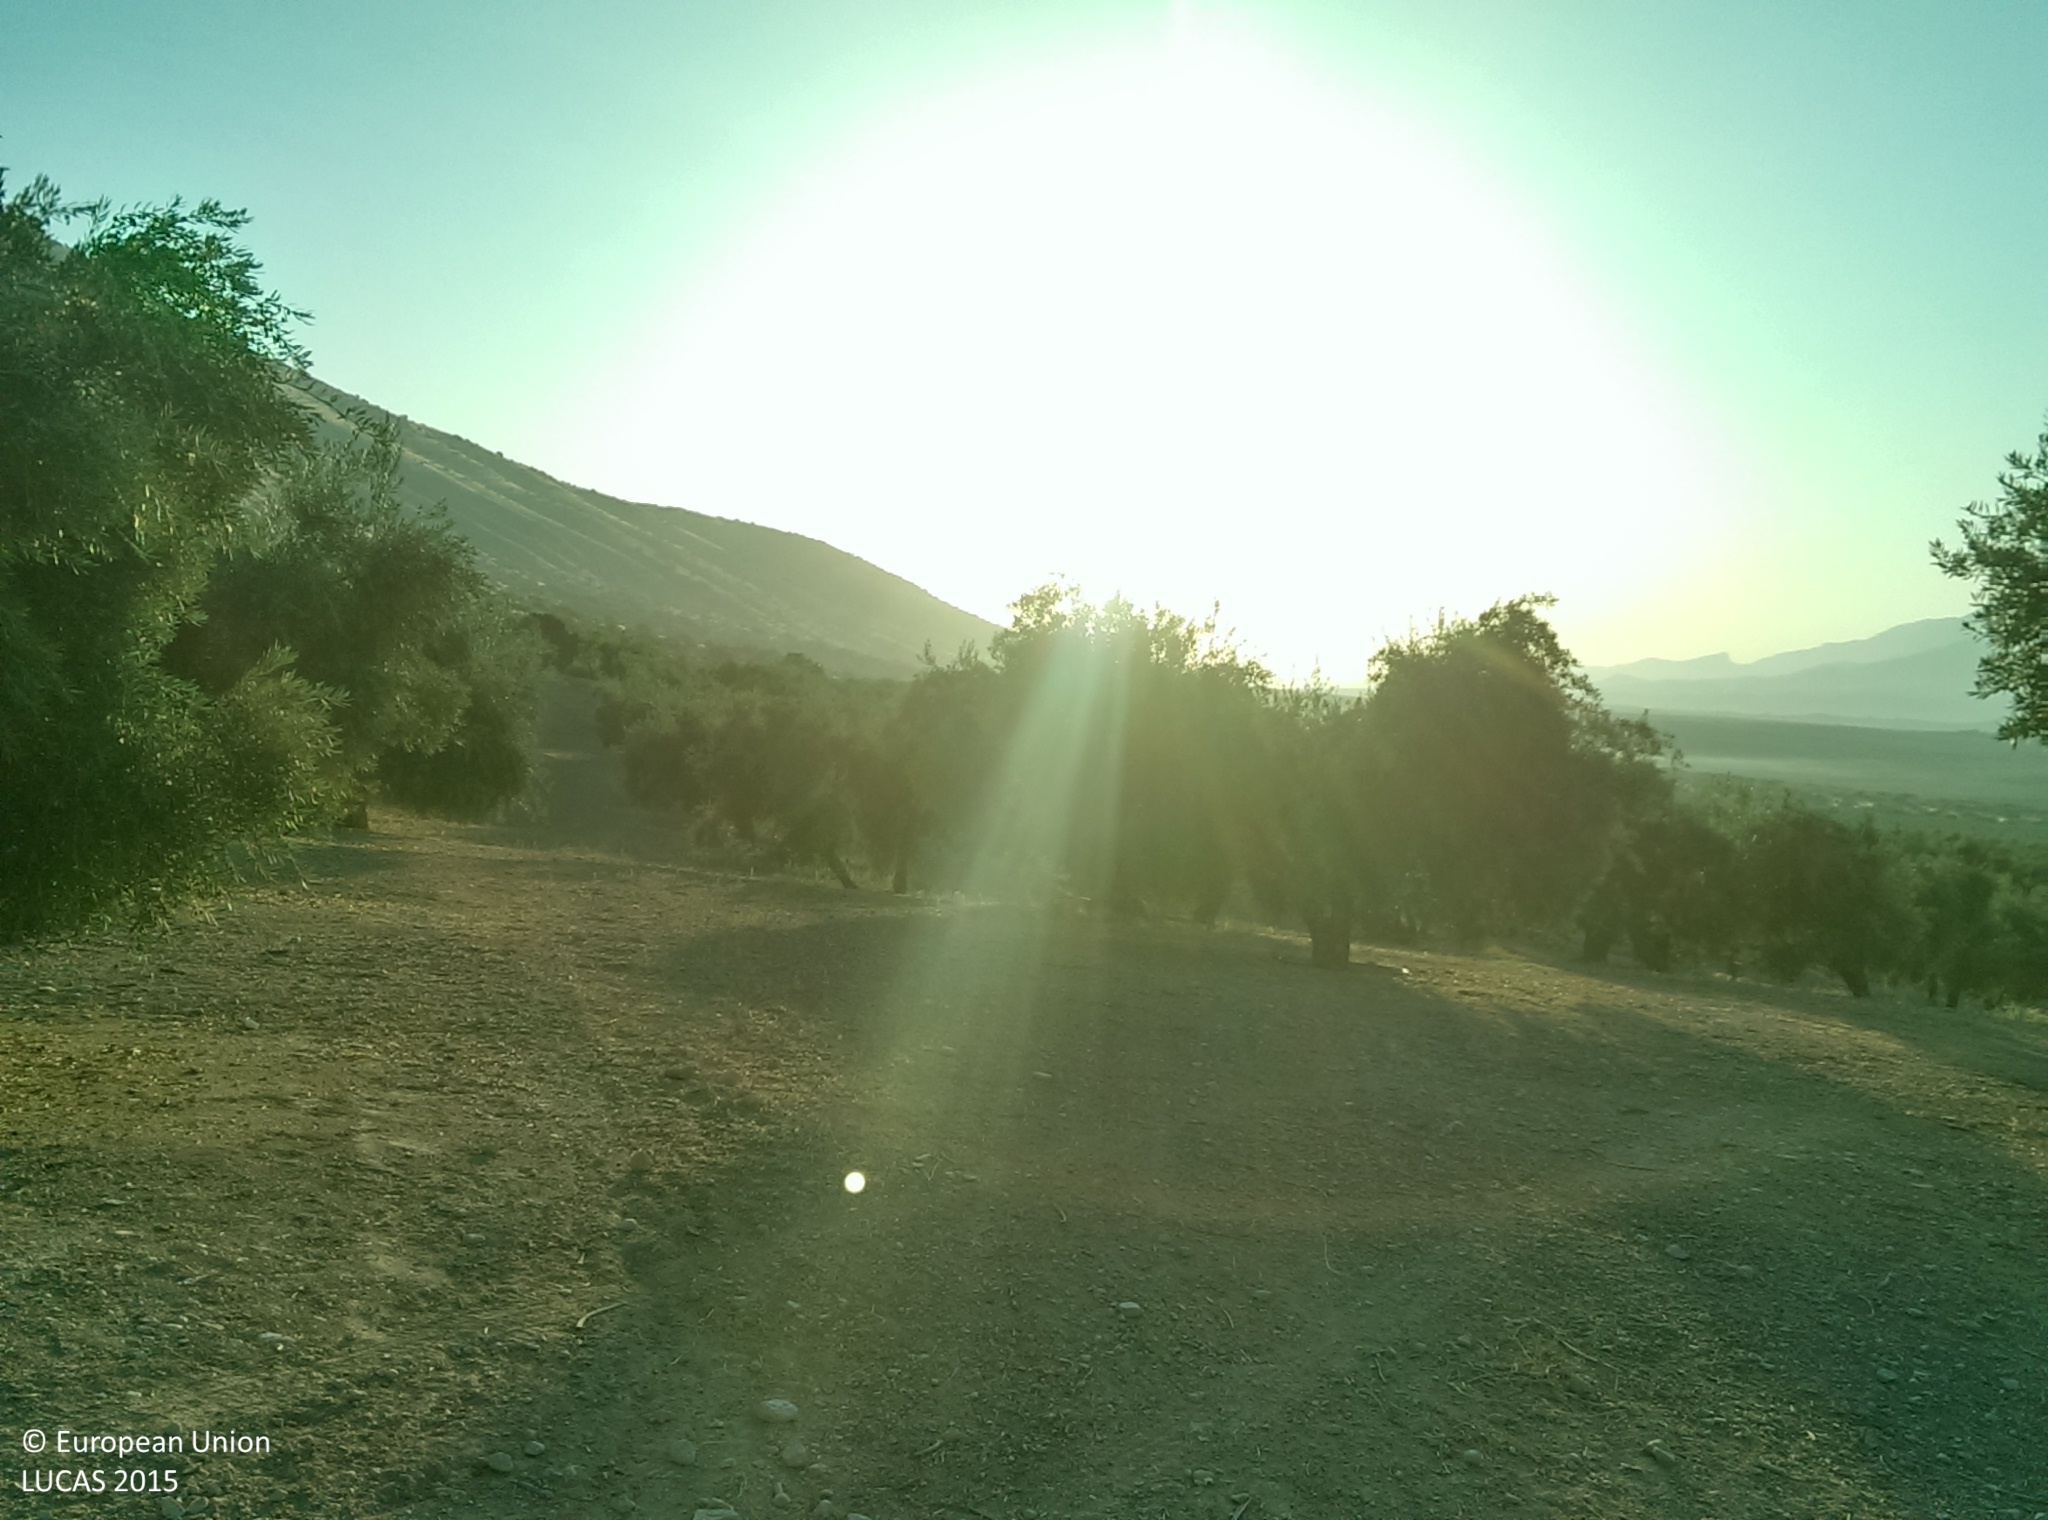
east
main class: Cropland
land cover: Olive groves
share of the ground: 50 - 75 %
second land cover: Other bare soil
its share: > 75 %
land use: Agriculture (excluding fallow land and kitchen gardens)
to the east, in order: Olive groves; Other bare soil; Fences; Grass margins; Tracks; Olive groves
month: July
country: ES
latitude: 37.3408
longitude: -3.6846
